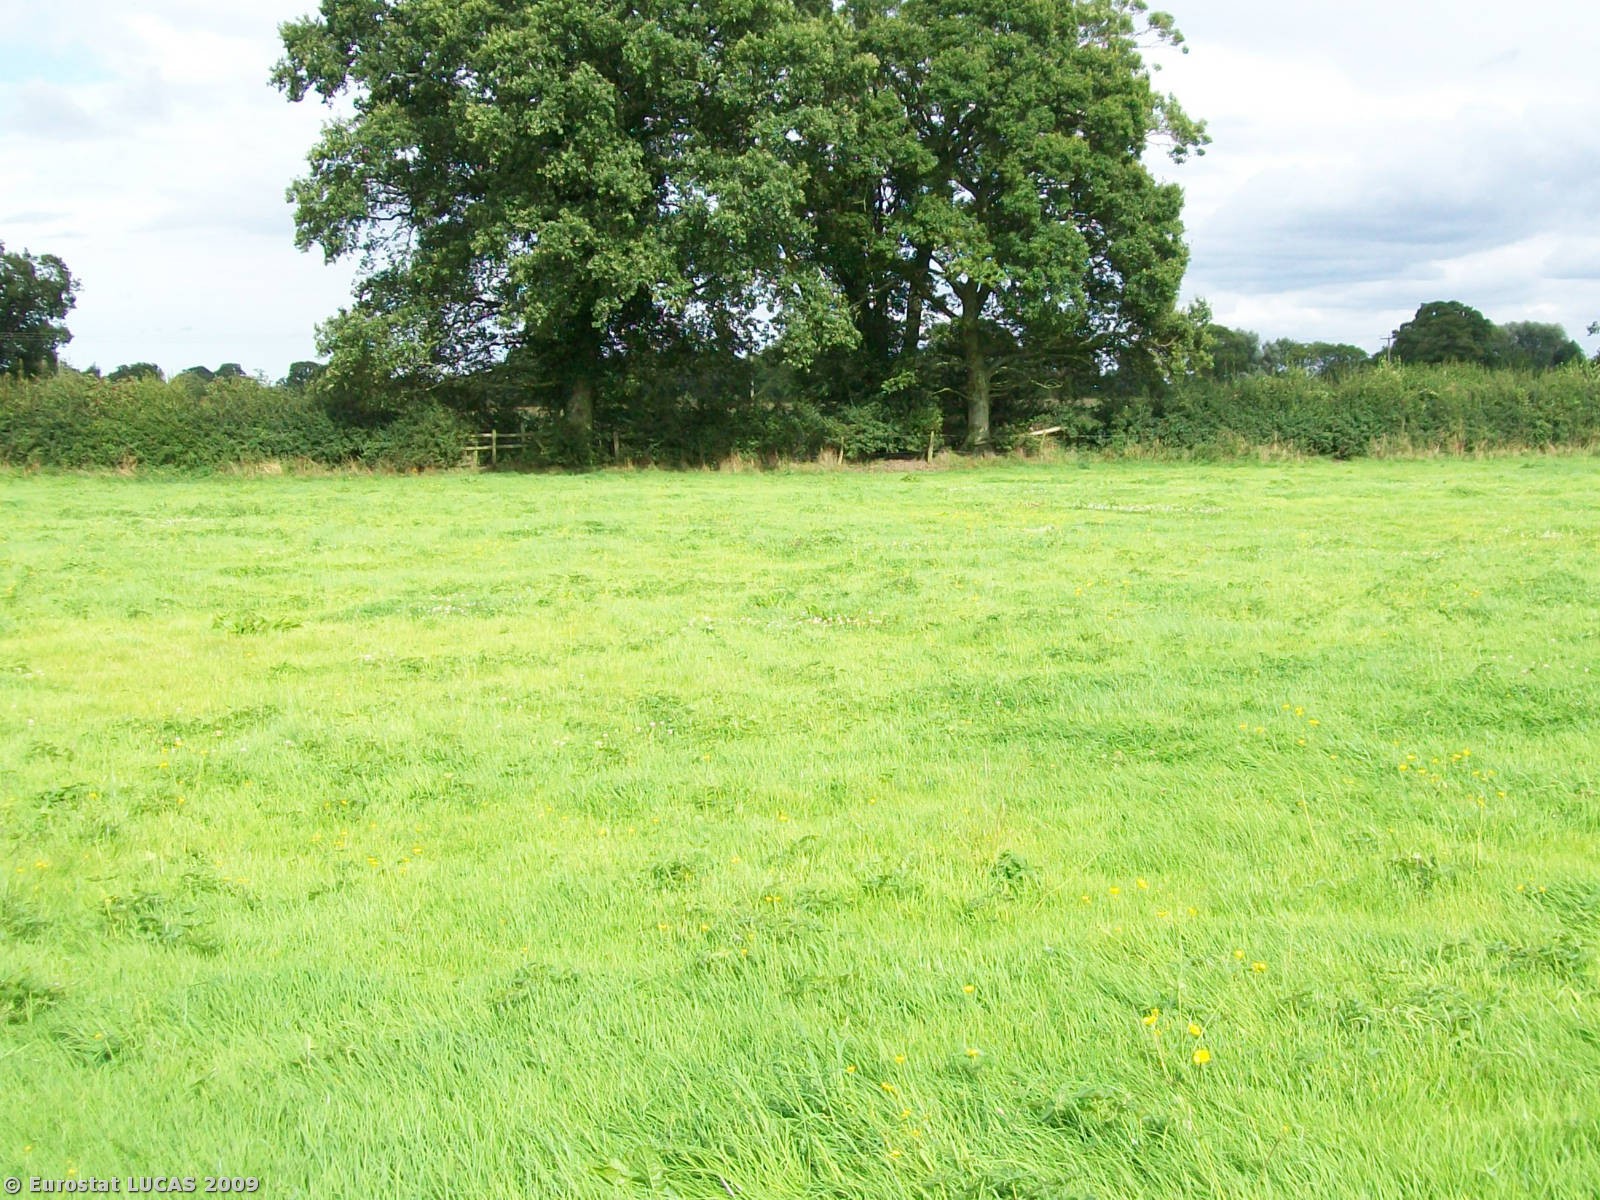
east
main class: Grassland
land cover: Grassland without tree/shrub cover
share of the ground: > 75 %
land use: Agriculture (excluding fallow land and kitchen gardens)
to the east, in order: Grassland without tree/shrub cover; Managed hedges; Fences; Temporary grasslands
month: August
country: GB
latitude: 51.8879
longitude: -2.4004
